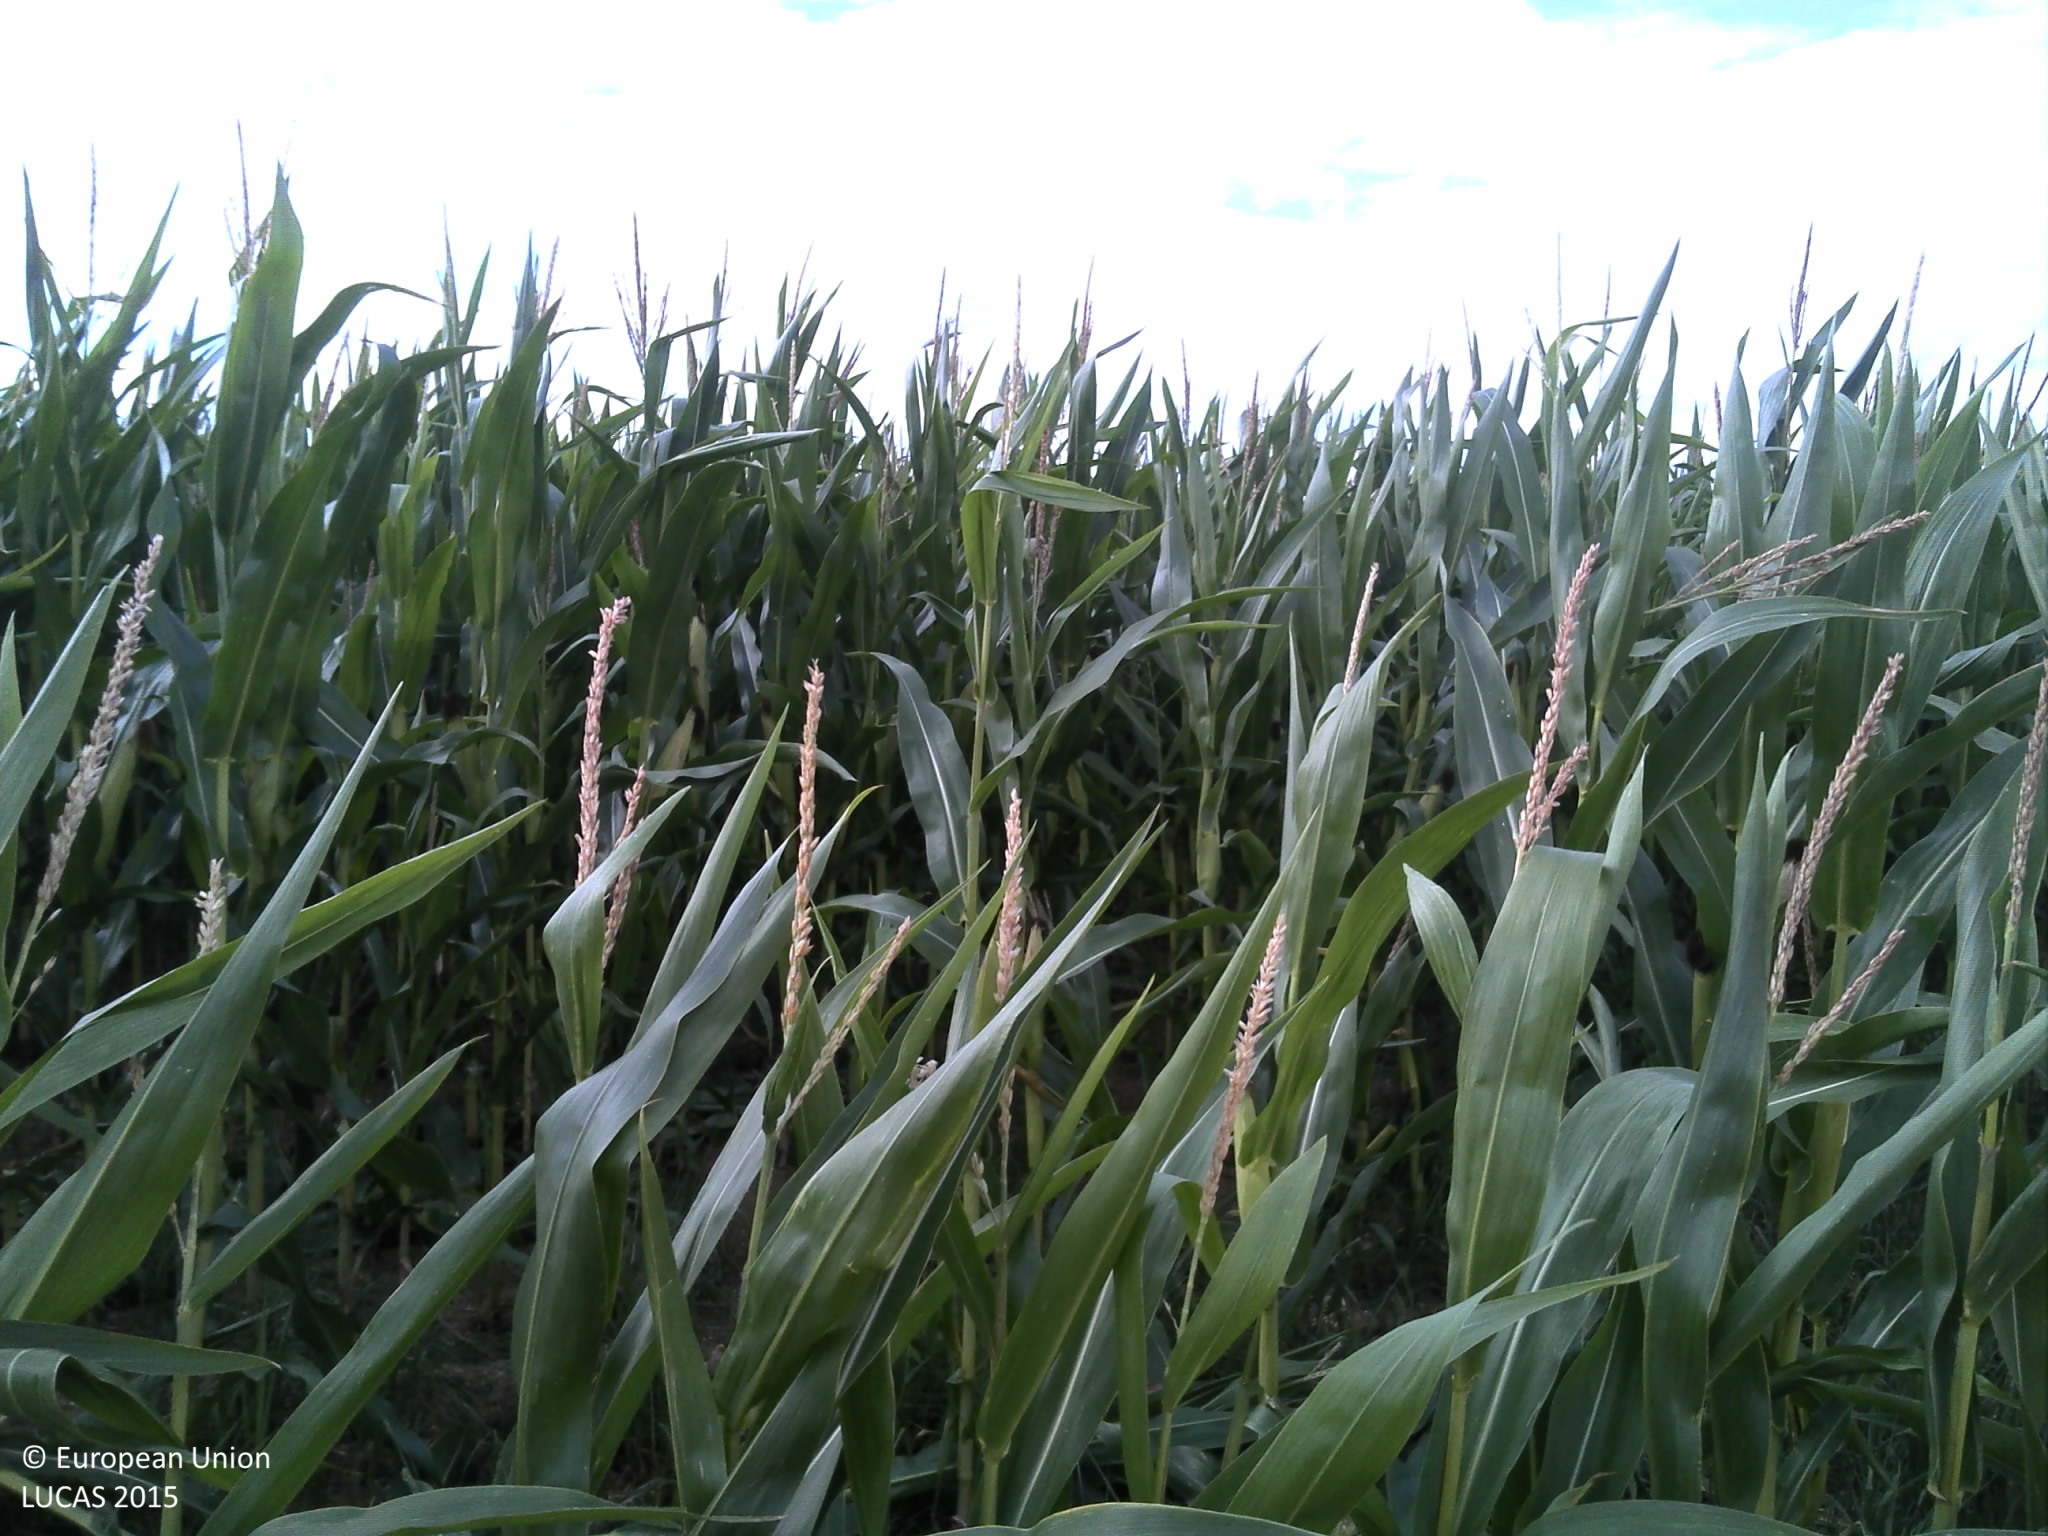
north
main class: Cropland
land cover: Maize
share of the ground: > 75 %
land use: Agriculture (excluding fallow land and kitchen gardens)
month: July
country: FR
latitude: 49.4755
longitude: 4.5173
